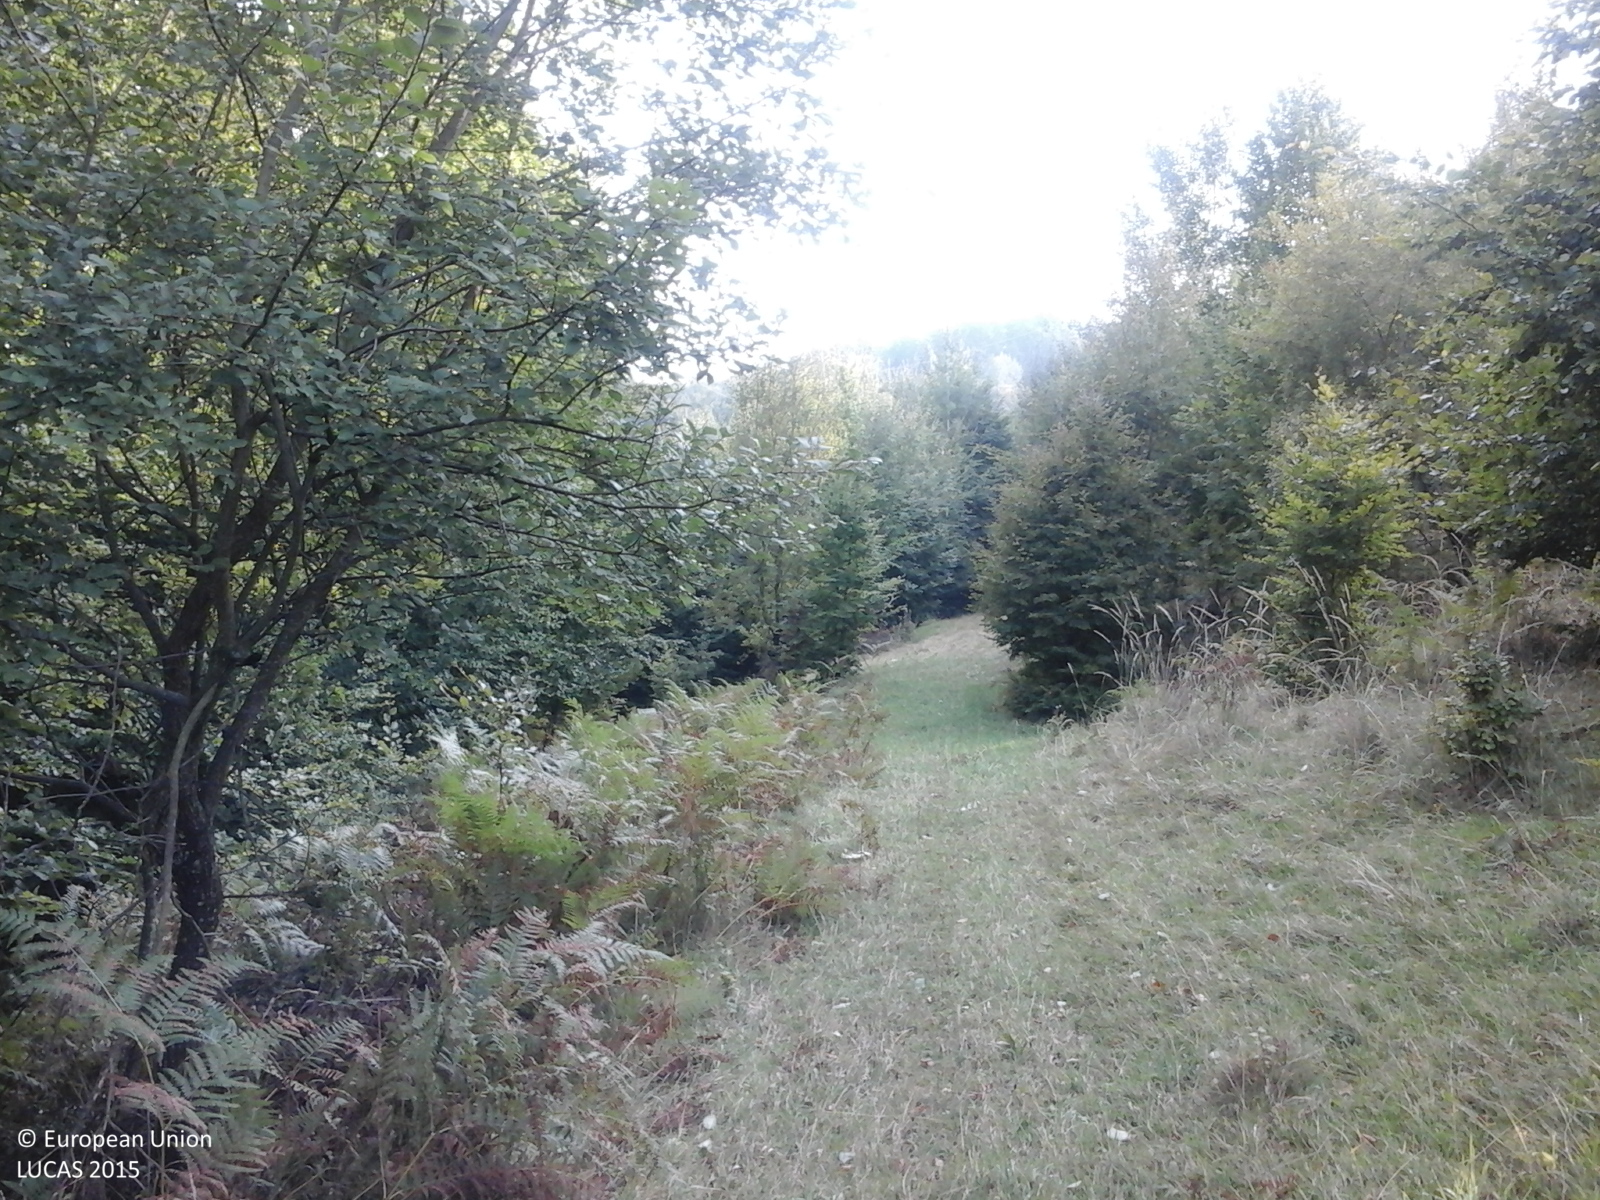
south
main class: Woodland
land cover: Broadleaved woodland
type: mesophytic deciduous forest
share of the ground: > 75 %
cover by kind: broadleaved forest trees 100 %
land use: Forestry
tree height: > 5 m
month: September
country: RO
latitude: 46.9089
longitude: 22.6466
